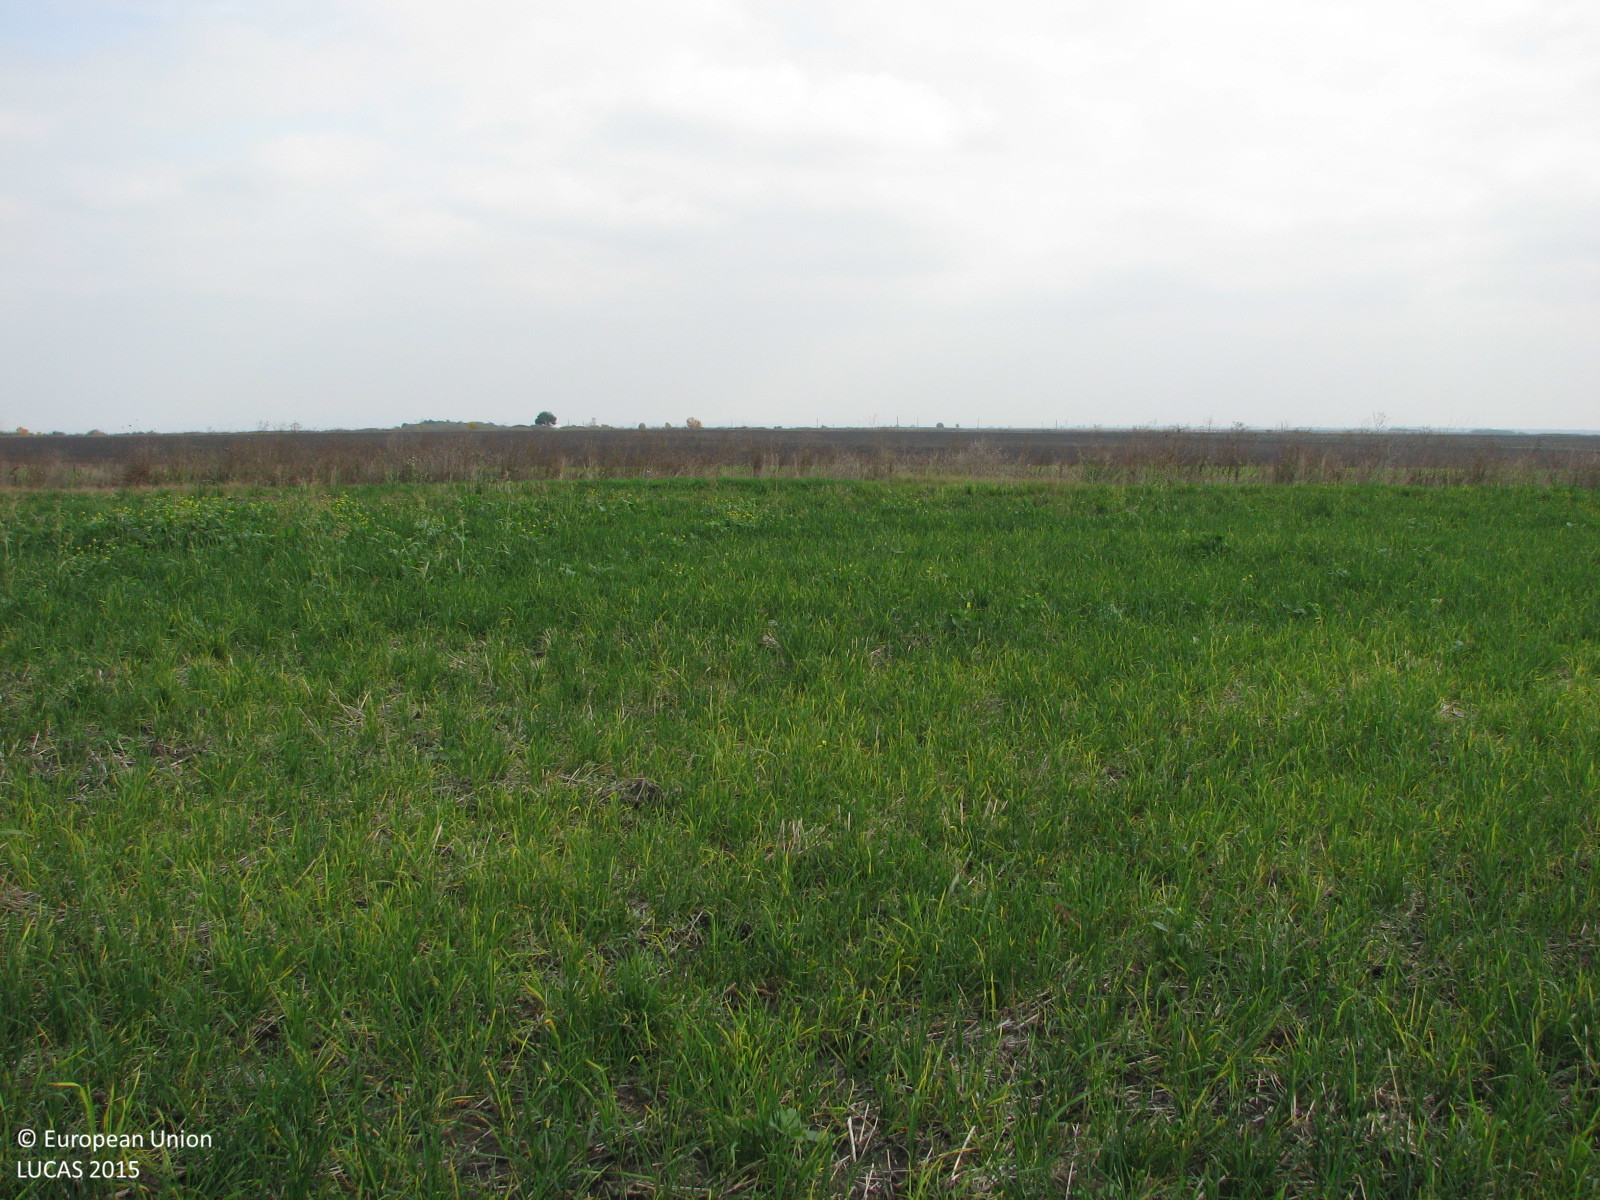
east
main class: Cropland
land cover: Common wheat
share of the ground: > 75 %
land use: Agriculture (excluding fallow land and kitchen gardens)
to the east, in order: Common wheat; Tracks; Grass margins; Ditches and canals; Common wheat; Other bare soil
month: October
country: BG
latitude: 42.3403
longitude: 26.4880
